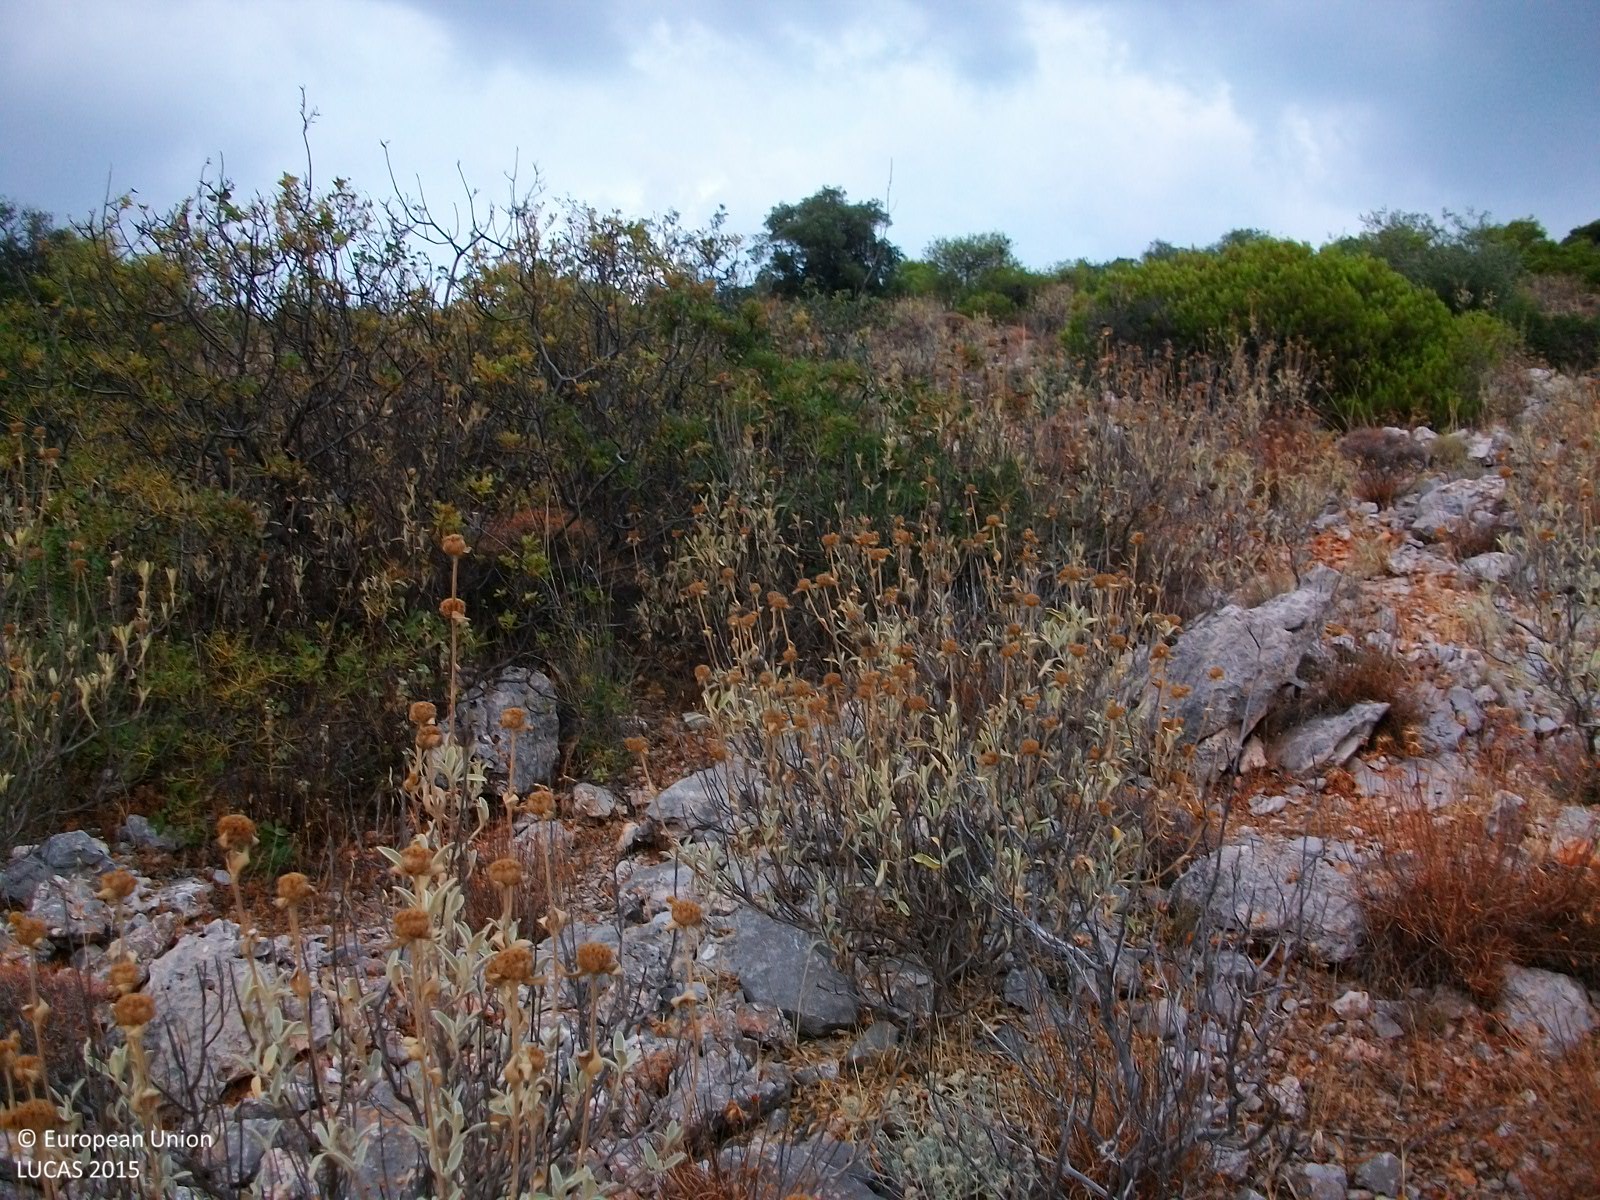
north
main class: Woodland
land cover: Pine dominated coniferous woodland
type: coniferous forest of the mediterranean region
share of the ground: 10 - 25 %
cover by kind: shrubs 30 %, herbaceous plants 30 %, coniferous forest trees 20 %, consolidated bare surface 20 %
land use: Semi-natural and natural areas not in use
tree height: < 5 m
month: June
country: GR
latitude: 38.0264
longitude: 23.6393
